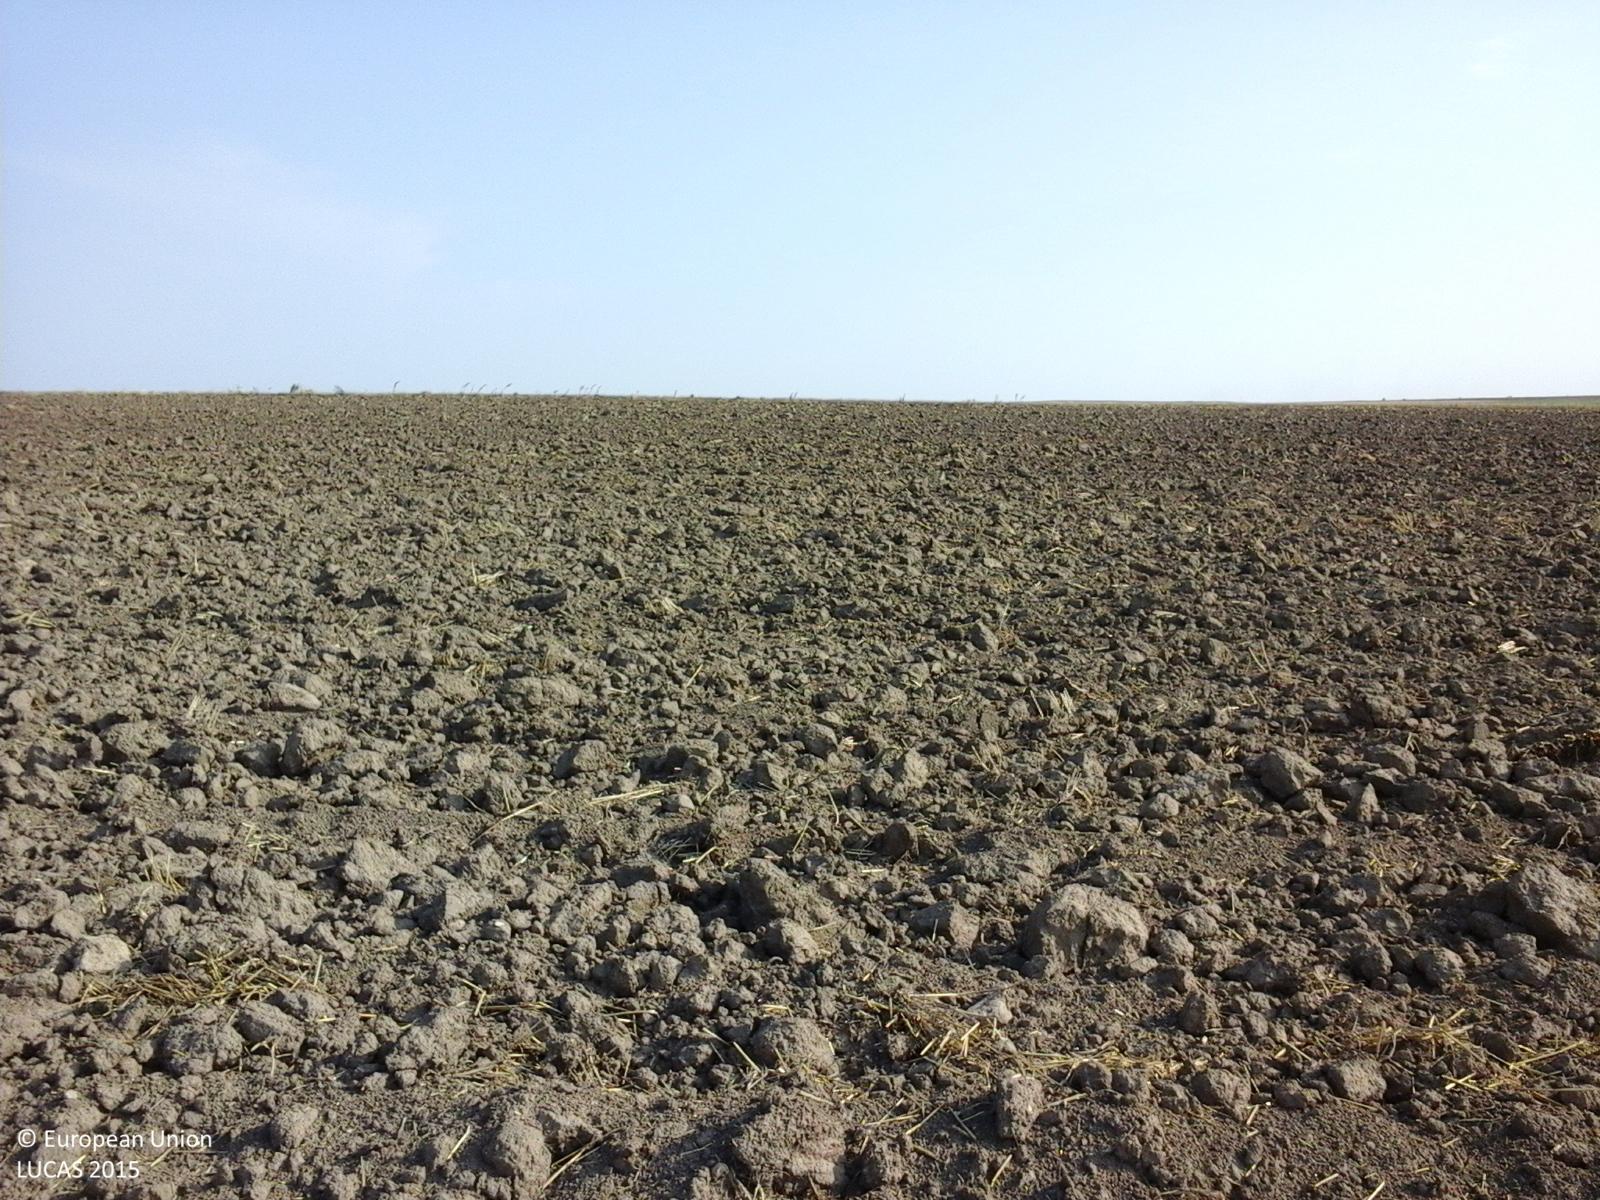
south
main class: Cropland
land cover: Common wheat
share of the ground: < 10 %
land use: Agriculture (excluding fallow land and kitchen gardens)
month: August
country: RO
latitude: 44.1103
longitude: 28.3943
